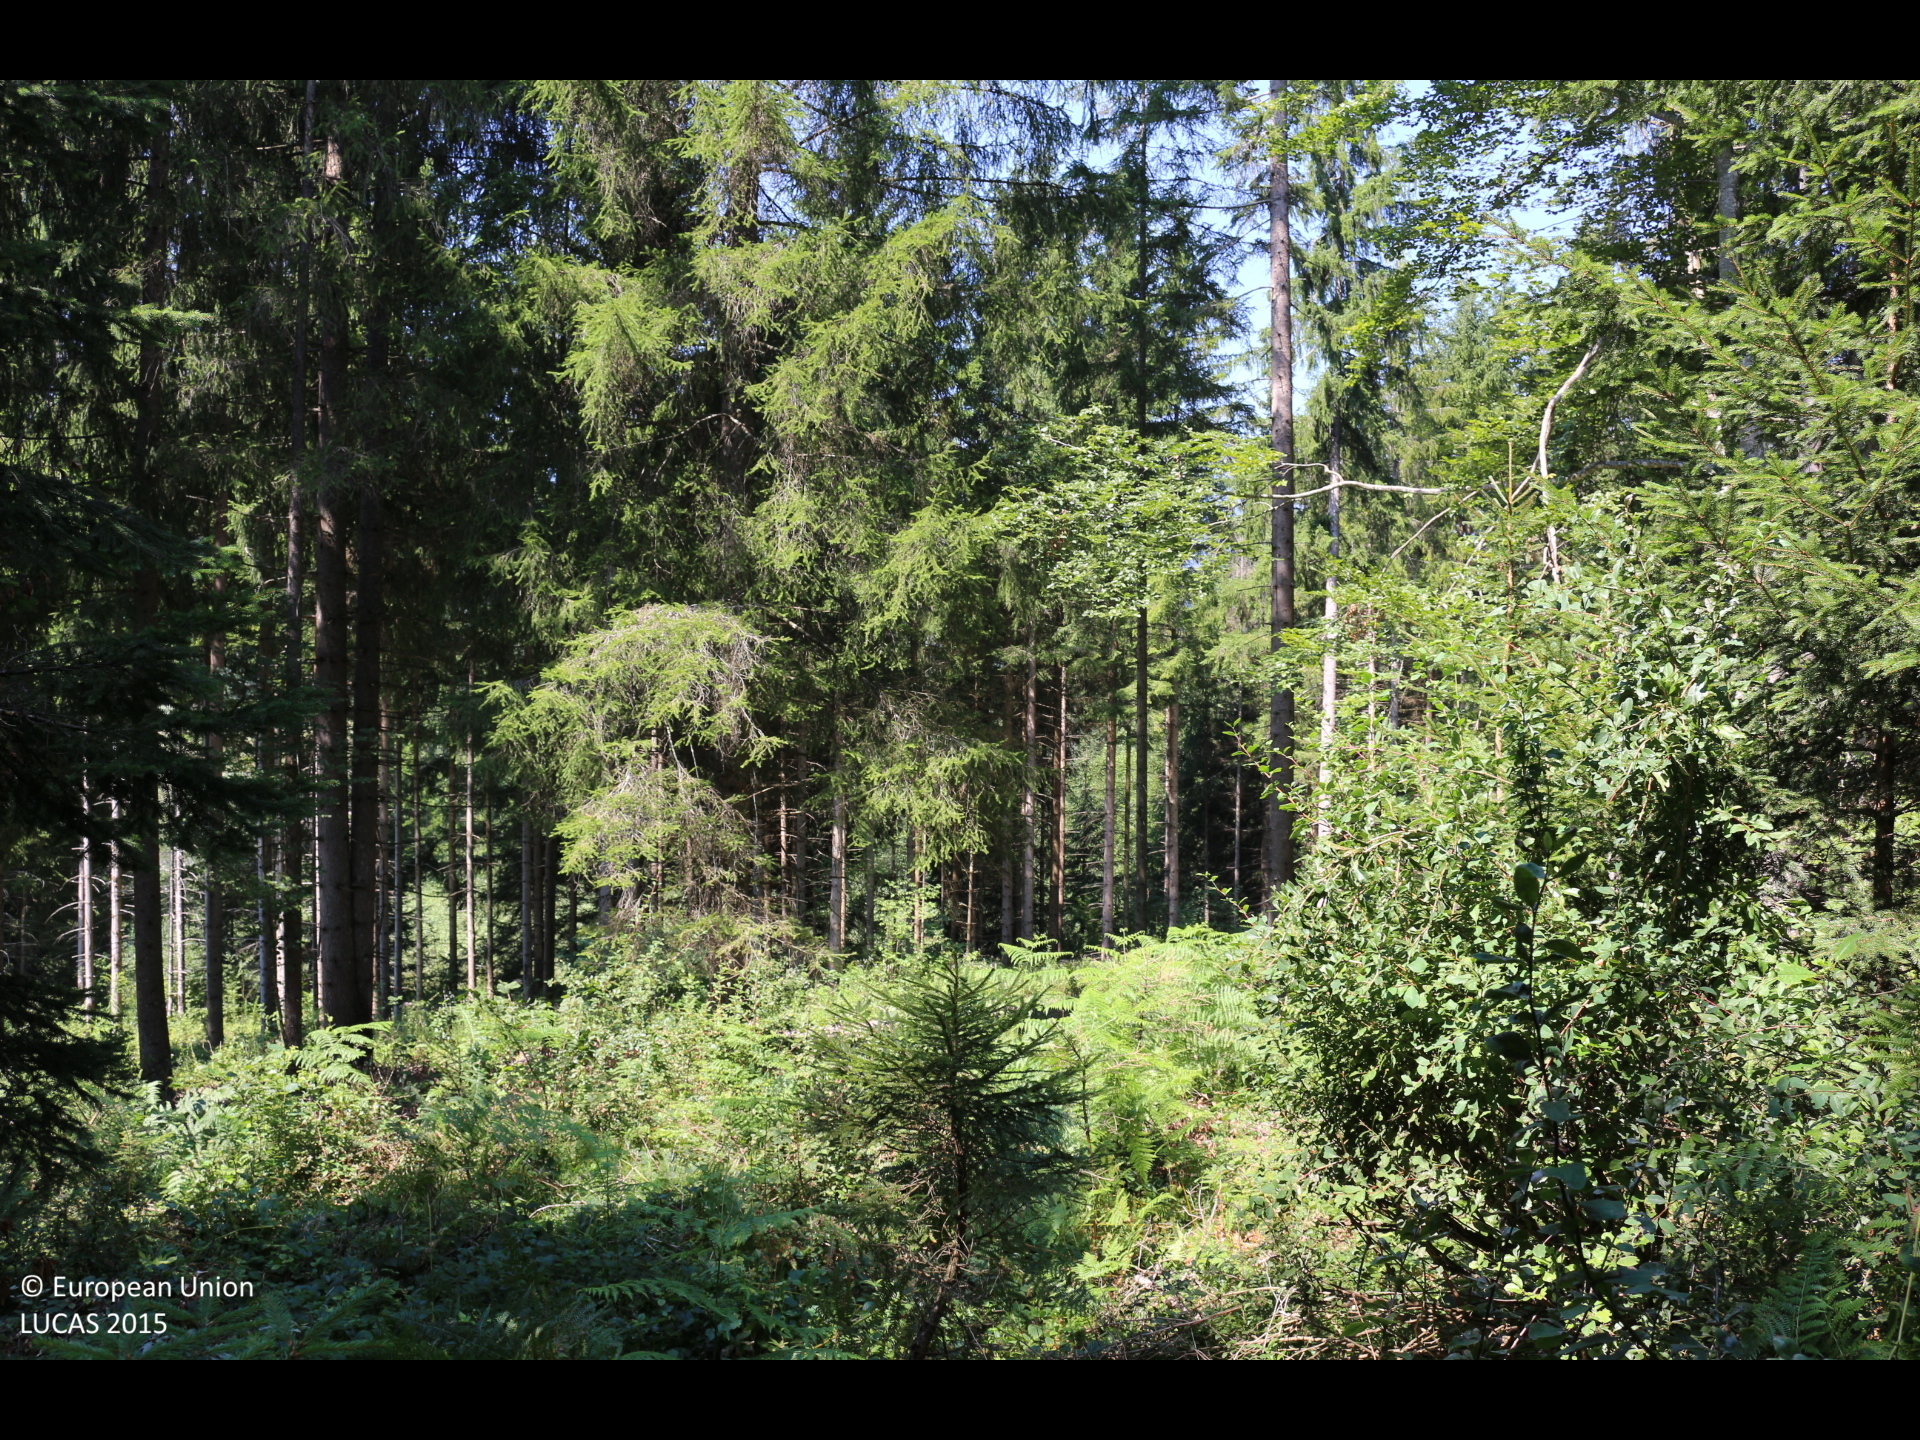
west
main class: Woodland
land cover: Spruce dominated mixed woodland
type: alpine coniferous forest
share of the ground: > 75 %
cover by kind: coniferous forest trees 65 %, broadleaved forest trees 25 %, shrubs 5 %, herbaceous plants 5 %
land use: Forestry
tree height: > 5 m
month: August
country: AT
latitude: 46.6795
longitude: 13.2787
